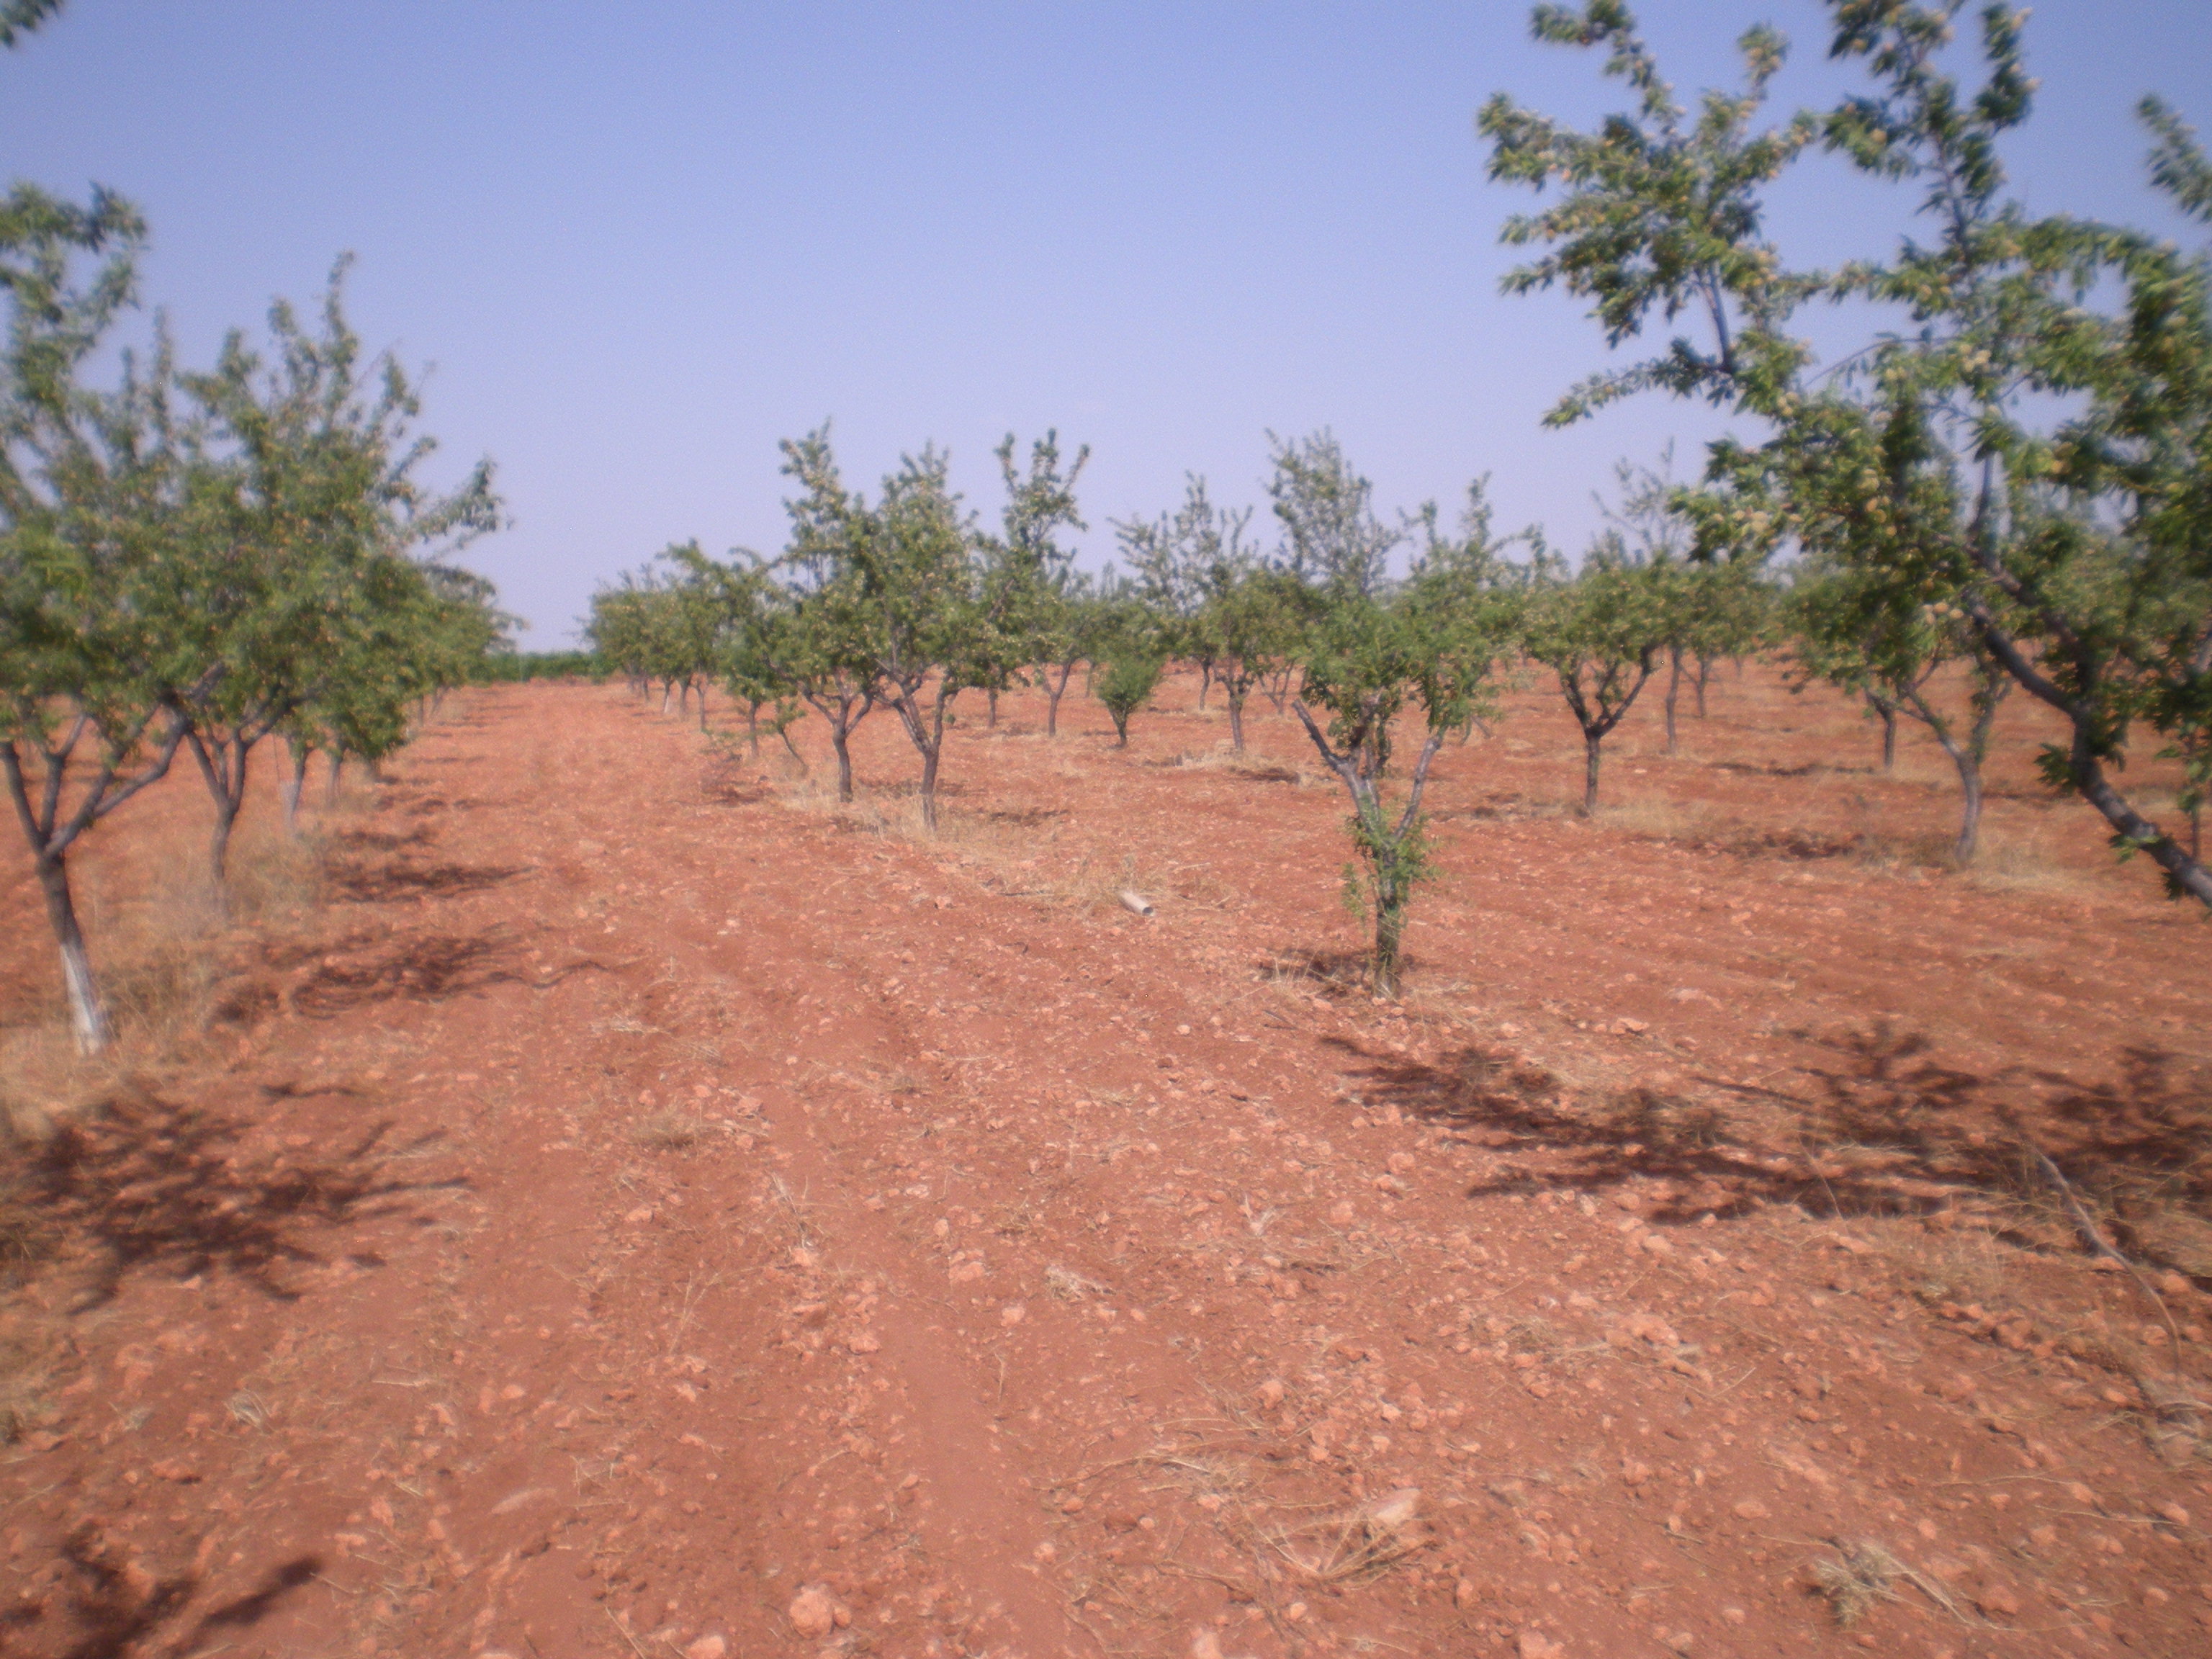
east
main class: Cropland
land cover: Nuts trees
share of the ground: 25 - 50 %
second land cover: Other bare soil
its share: > 75 %
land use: Agriculture (excluding fallow land and kitchen gardens)
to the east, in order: Nuts trees; Other bare soil; Grass margins; Other bare soil; Vineyards
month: June
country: ES
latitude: 39.5346
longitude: -3.3431
